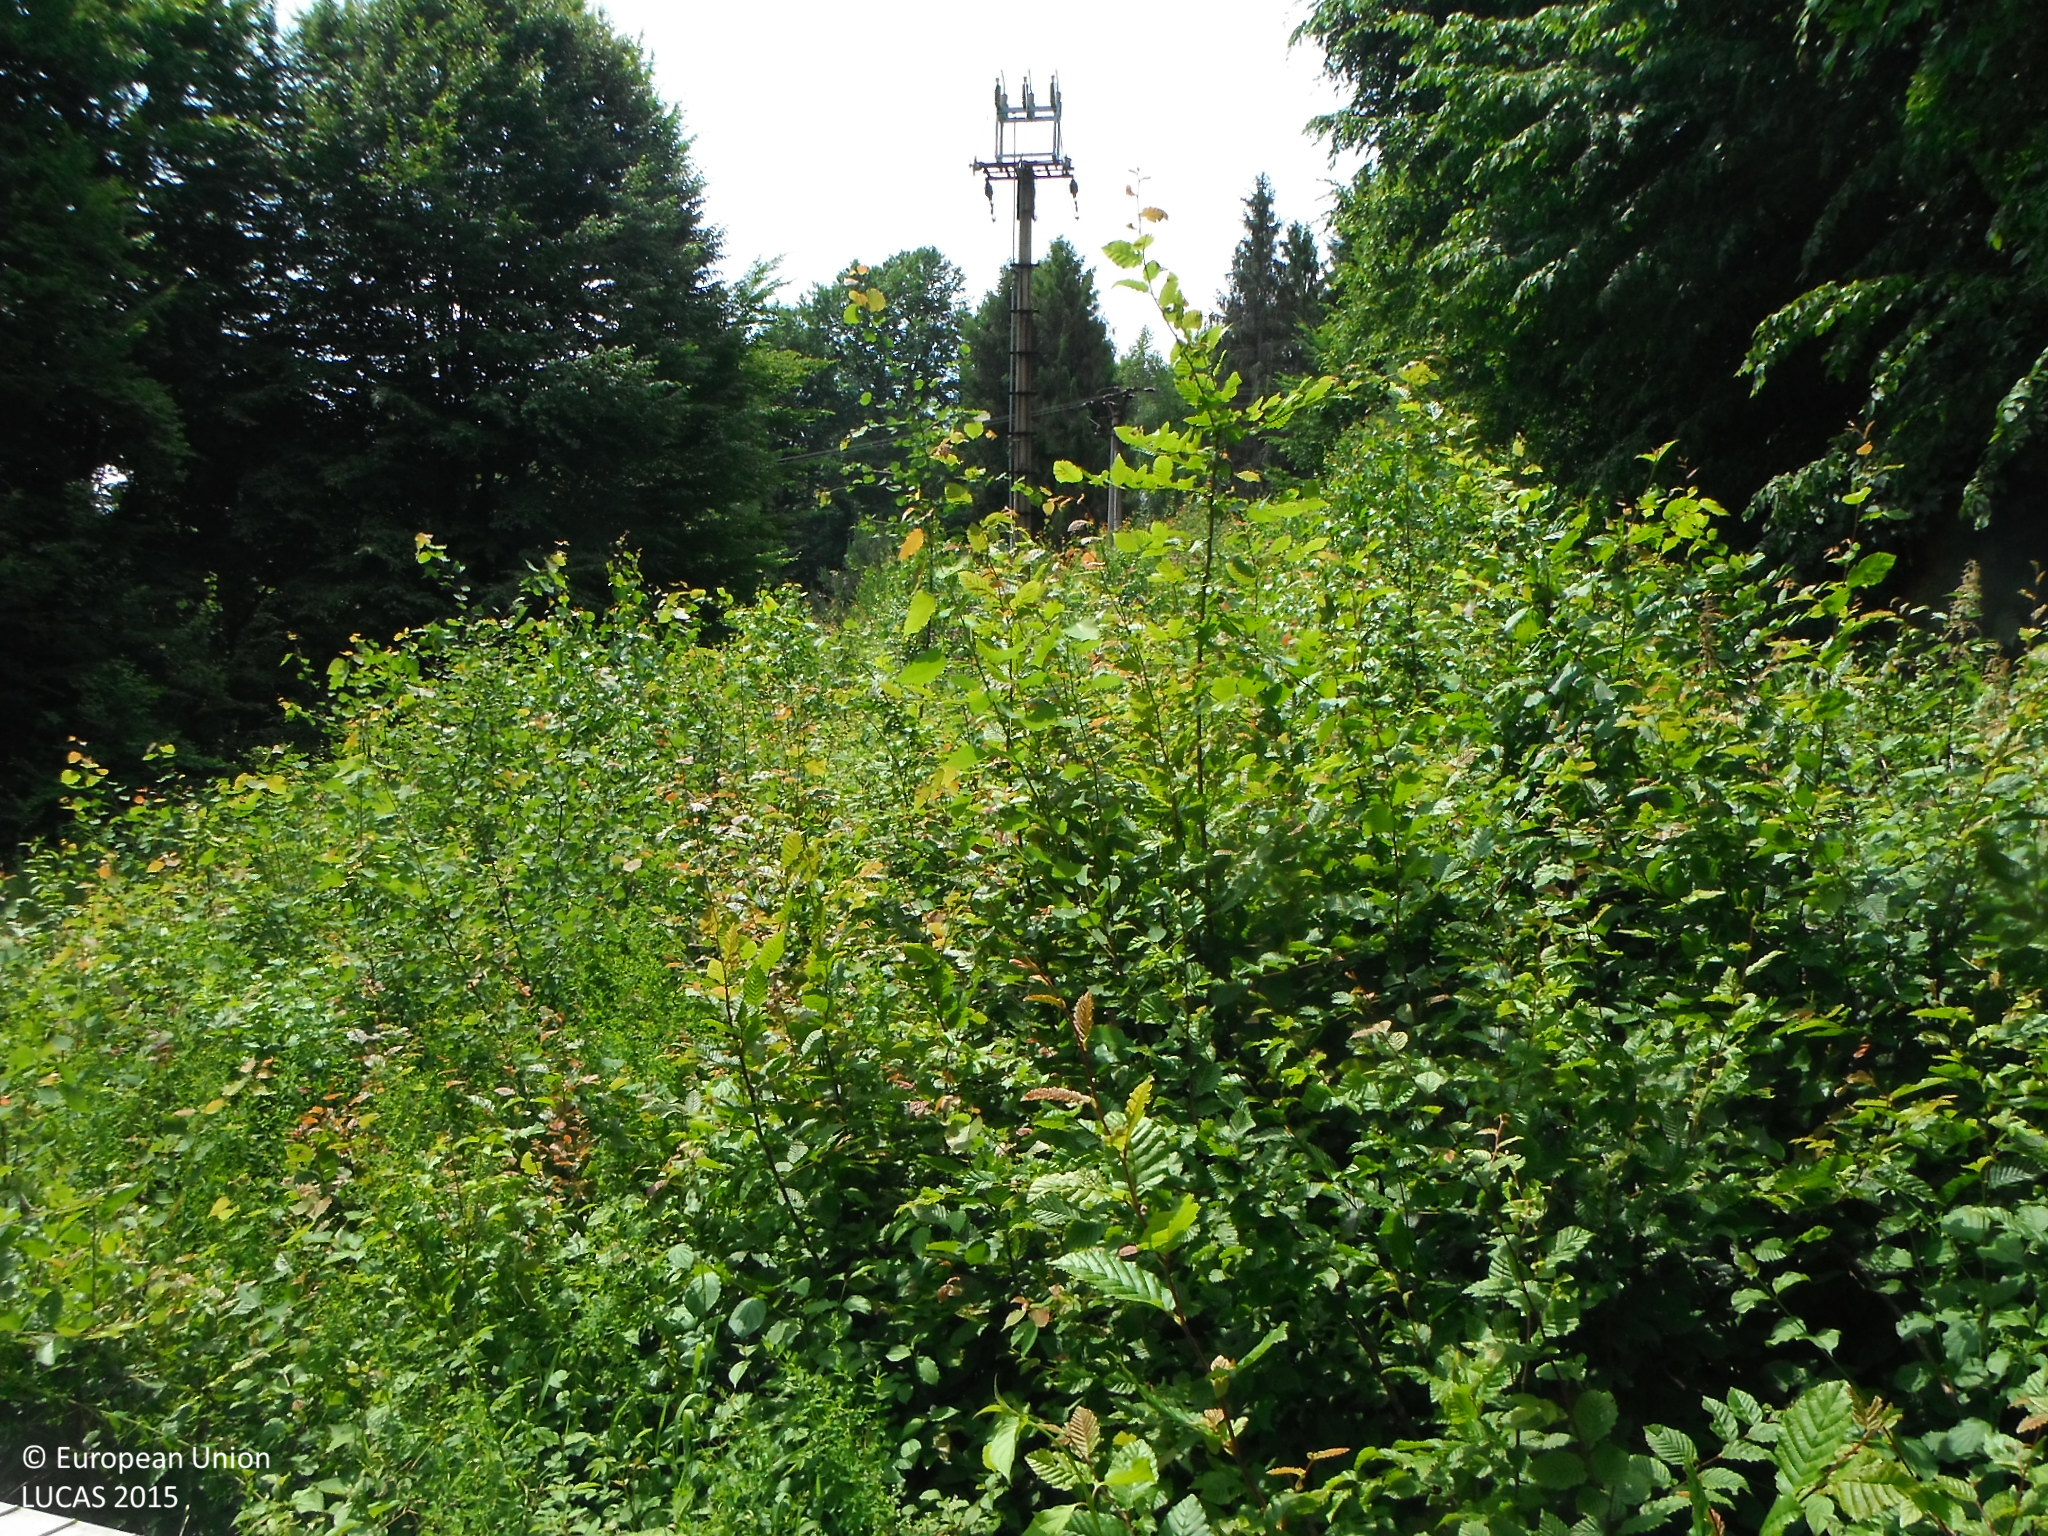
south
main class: Shrubland
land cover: Shrubland with sparse tree cover
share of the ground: > 75 %
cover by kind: shrubs 95 %, broadleaved forest trees 5 %
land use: Semi-natural and natural areas not in use
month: June
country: SK
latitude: 48.8449
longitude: 21.0662
